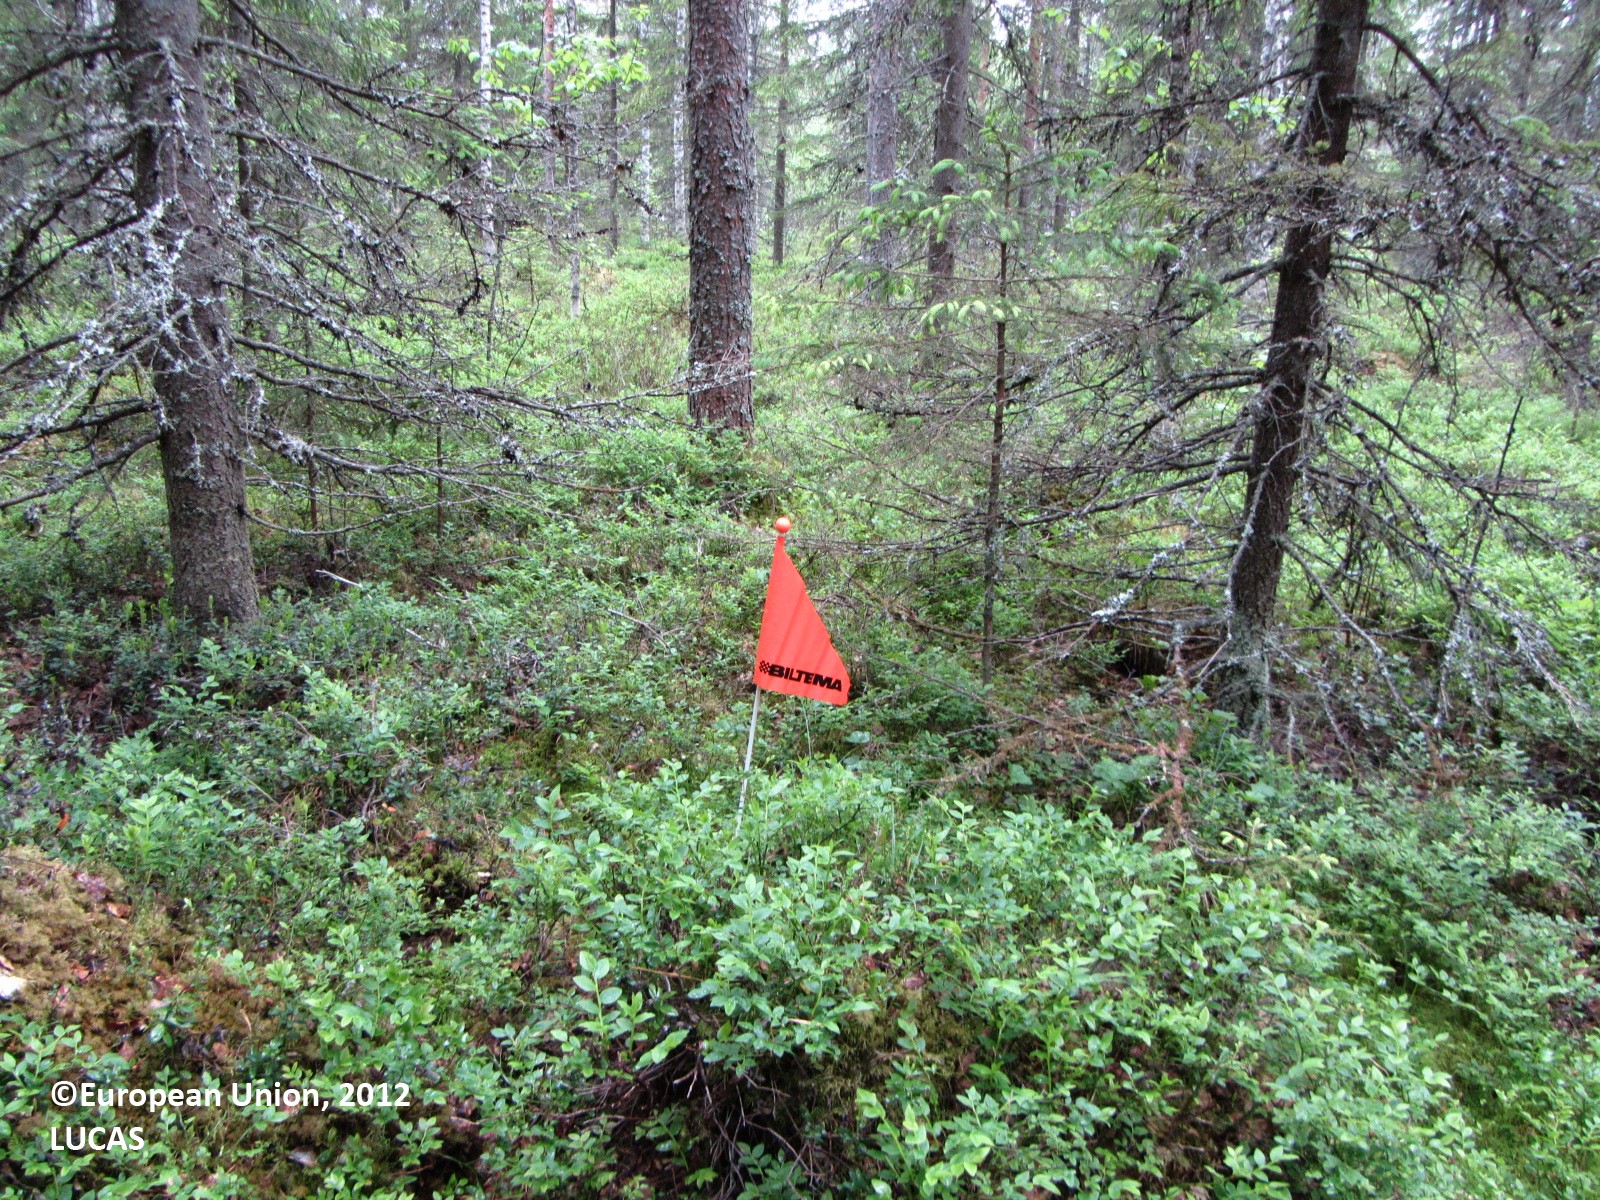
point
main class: Woodland
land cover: Spruce dominated mixed woodland
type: boreal forest
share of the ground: 50 - 75 %
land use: Forestry
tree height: > 5 m
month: June
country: FI
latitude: 62.4691
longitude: 24.9344
